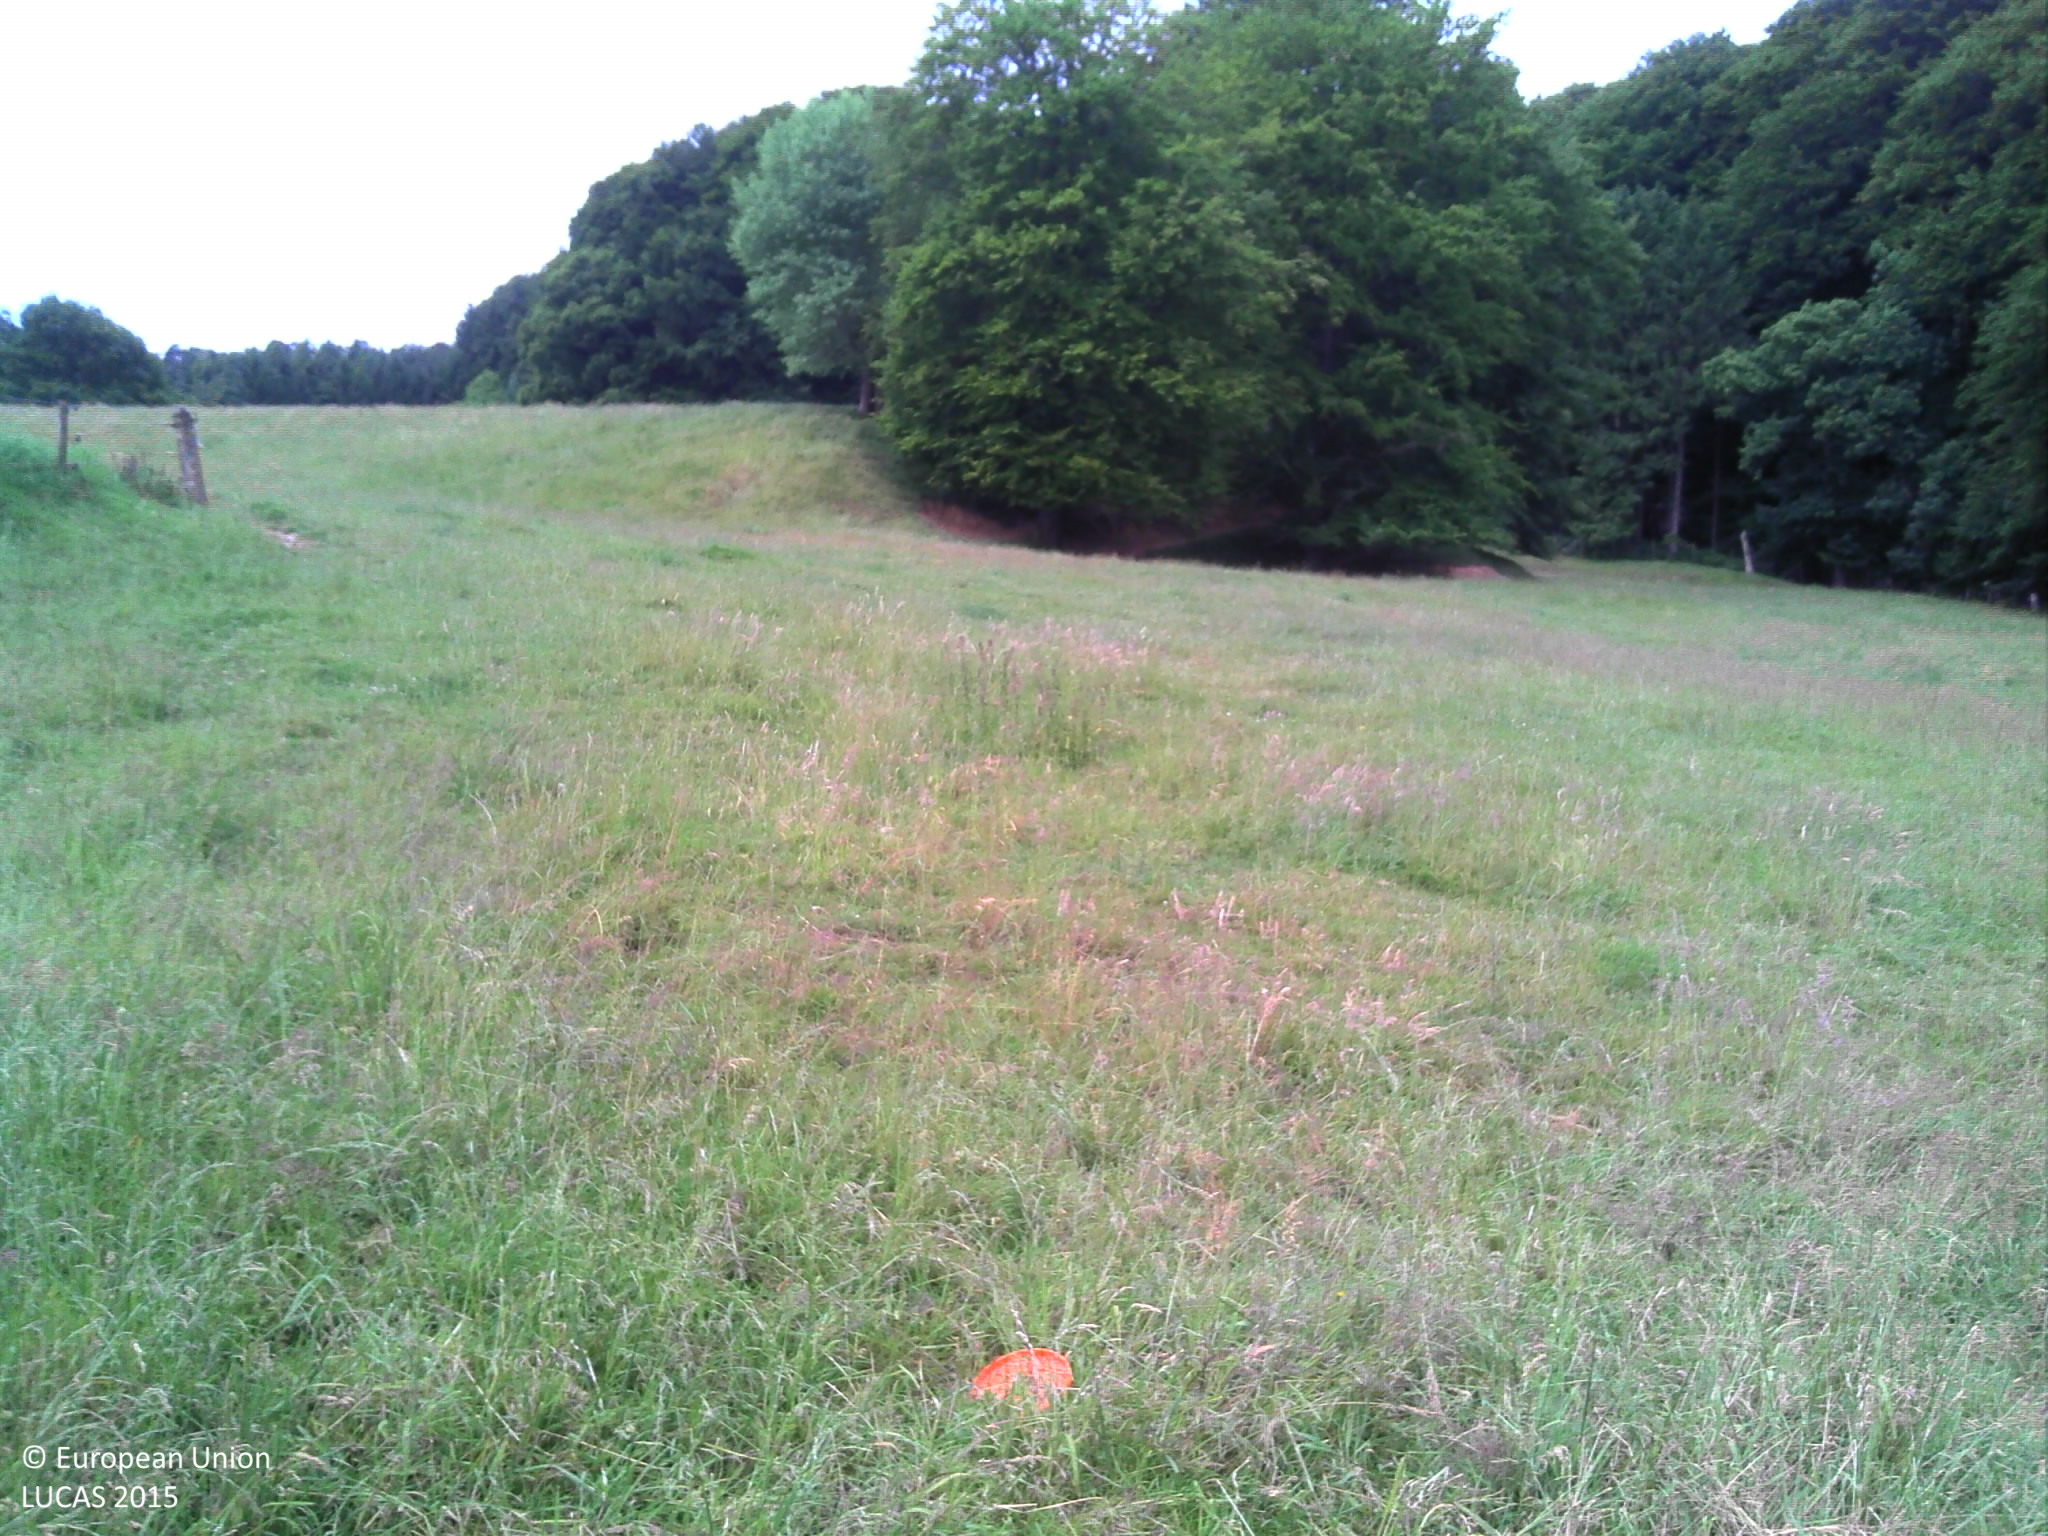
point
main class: Grassland
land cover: Grassland without tree/shrub cover
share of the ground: > 75 %
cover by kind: herbaceous plants 100 %
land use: Agriculture (excluding fallow land and kitchen gardens)
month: June
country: BE
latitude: 50.7651
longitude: 3.6553
